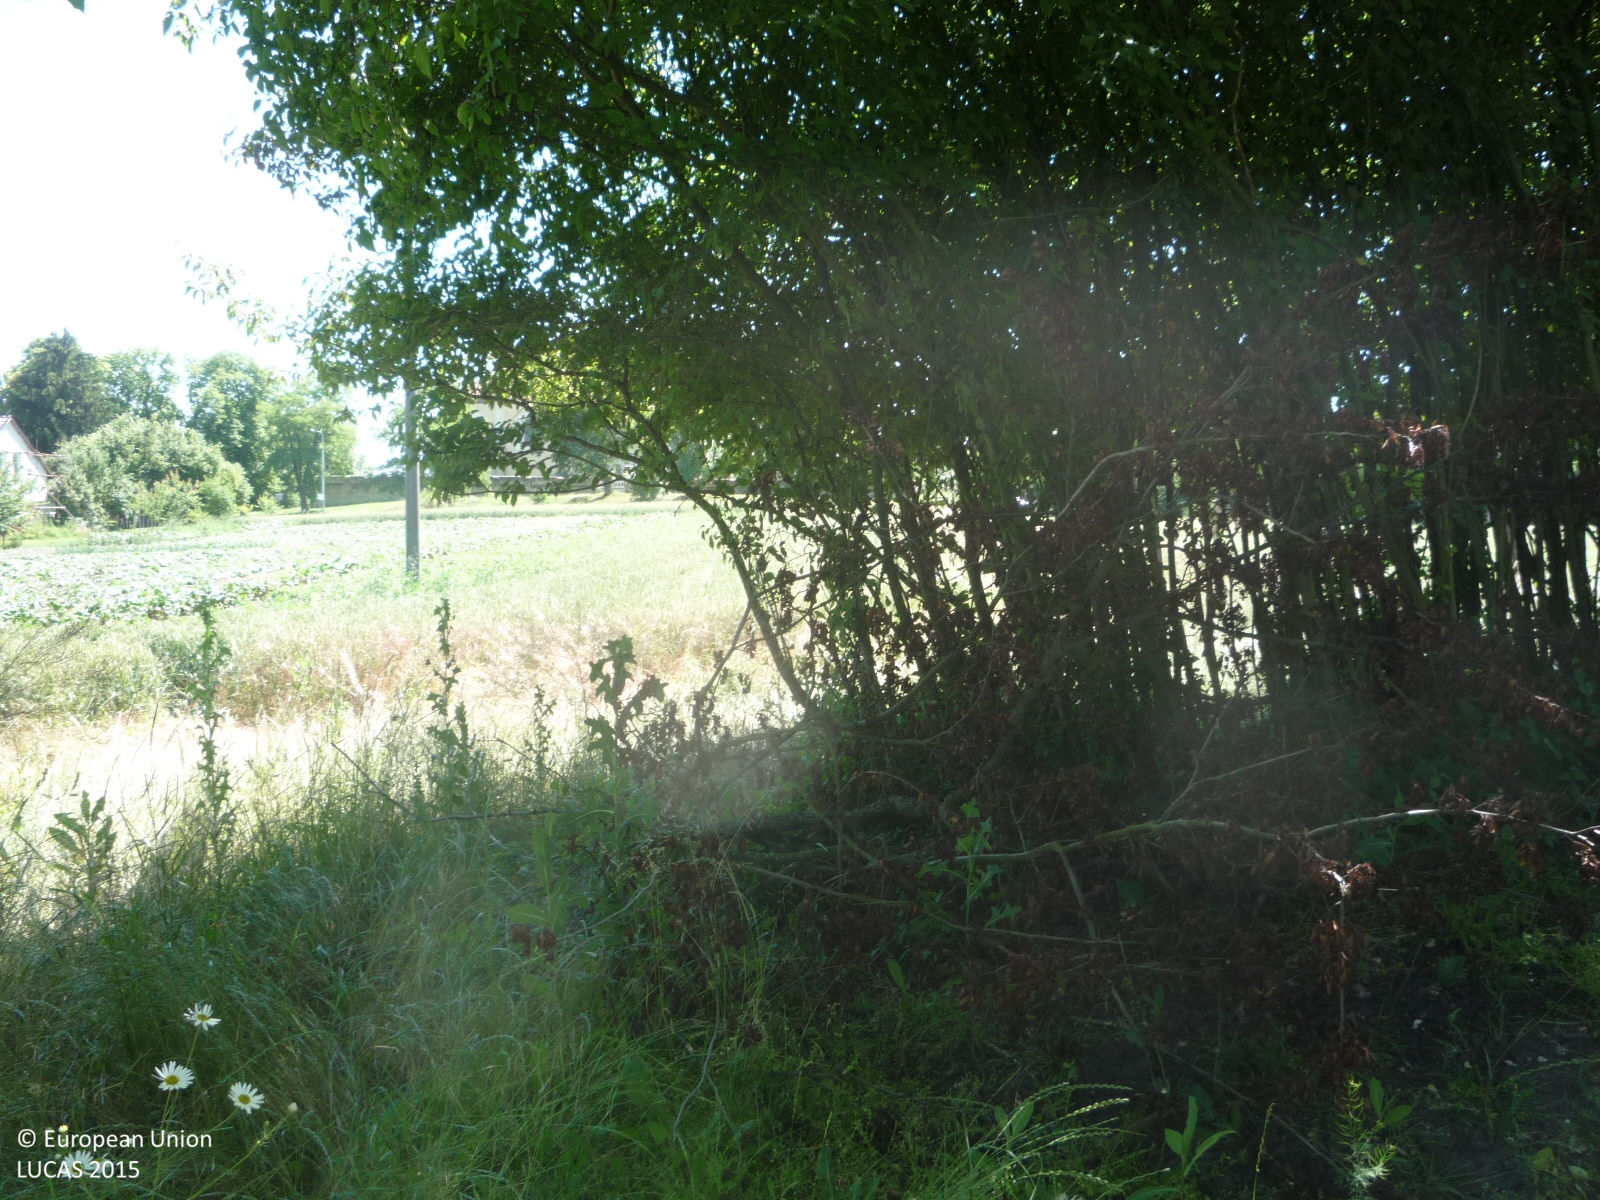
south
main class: Grassland
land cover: Grassland without tree/shrub cover
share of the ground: > 75 %
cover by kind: herbaceous plants 100 %
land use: Agriculture (excluding fallow land and kitchen gardens)
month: July
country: CZ
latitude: 50.2789
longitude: 15.2657
